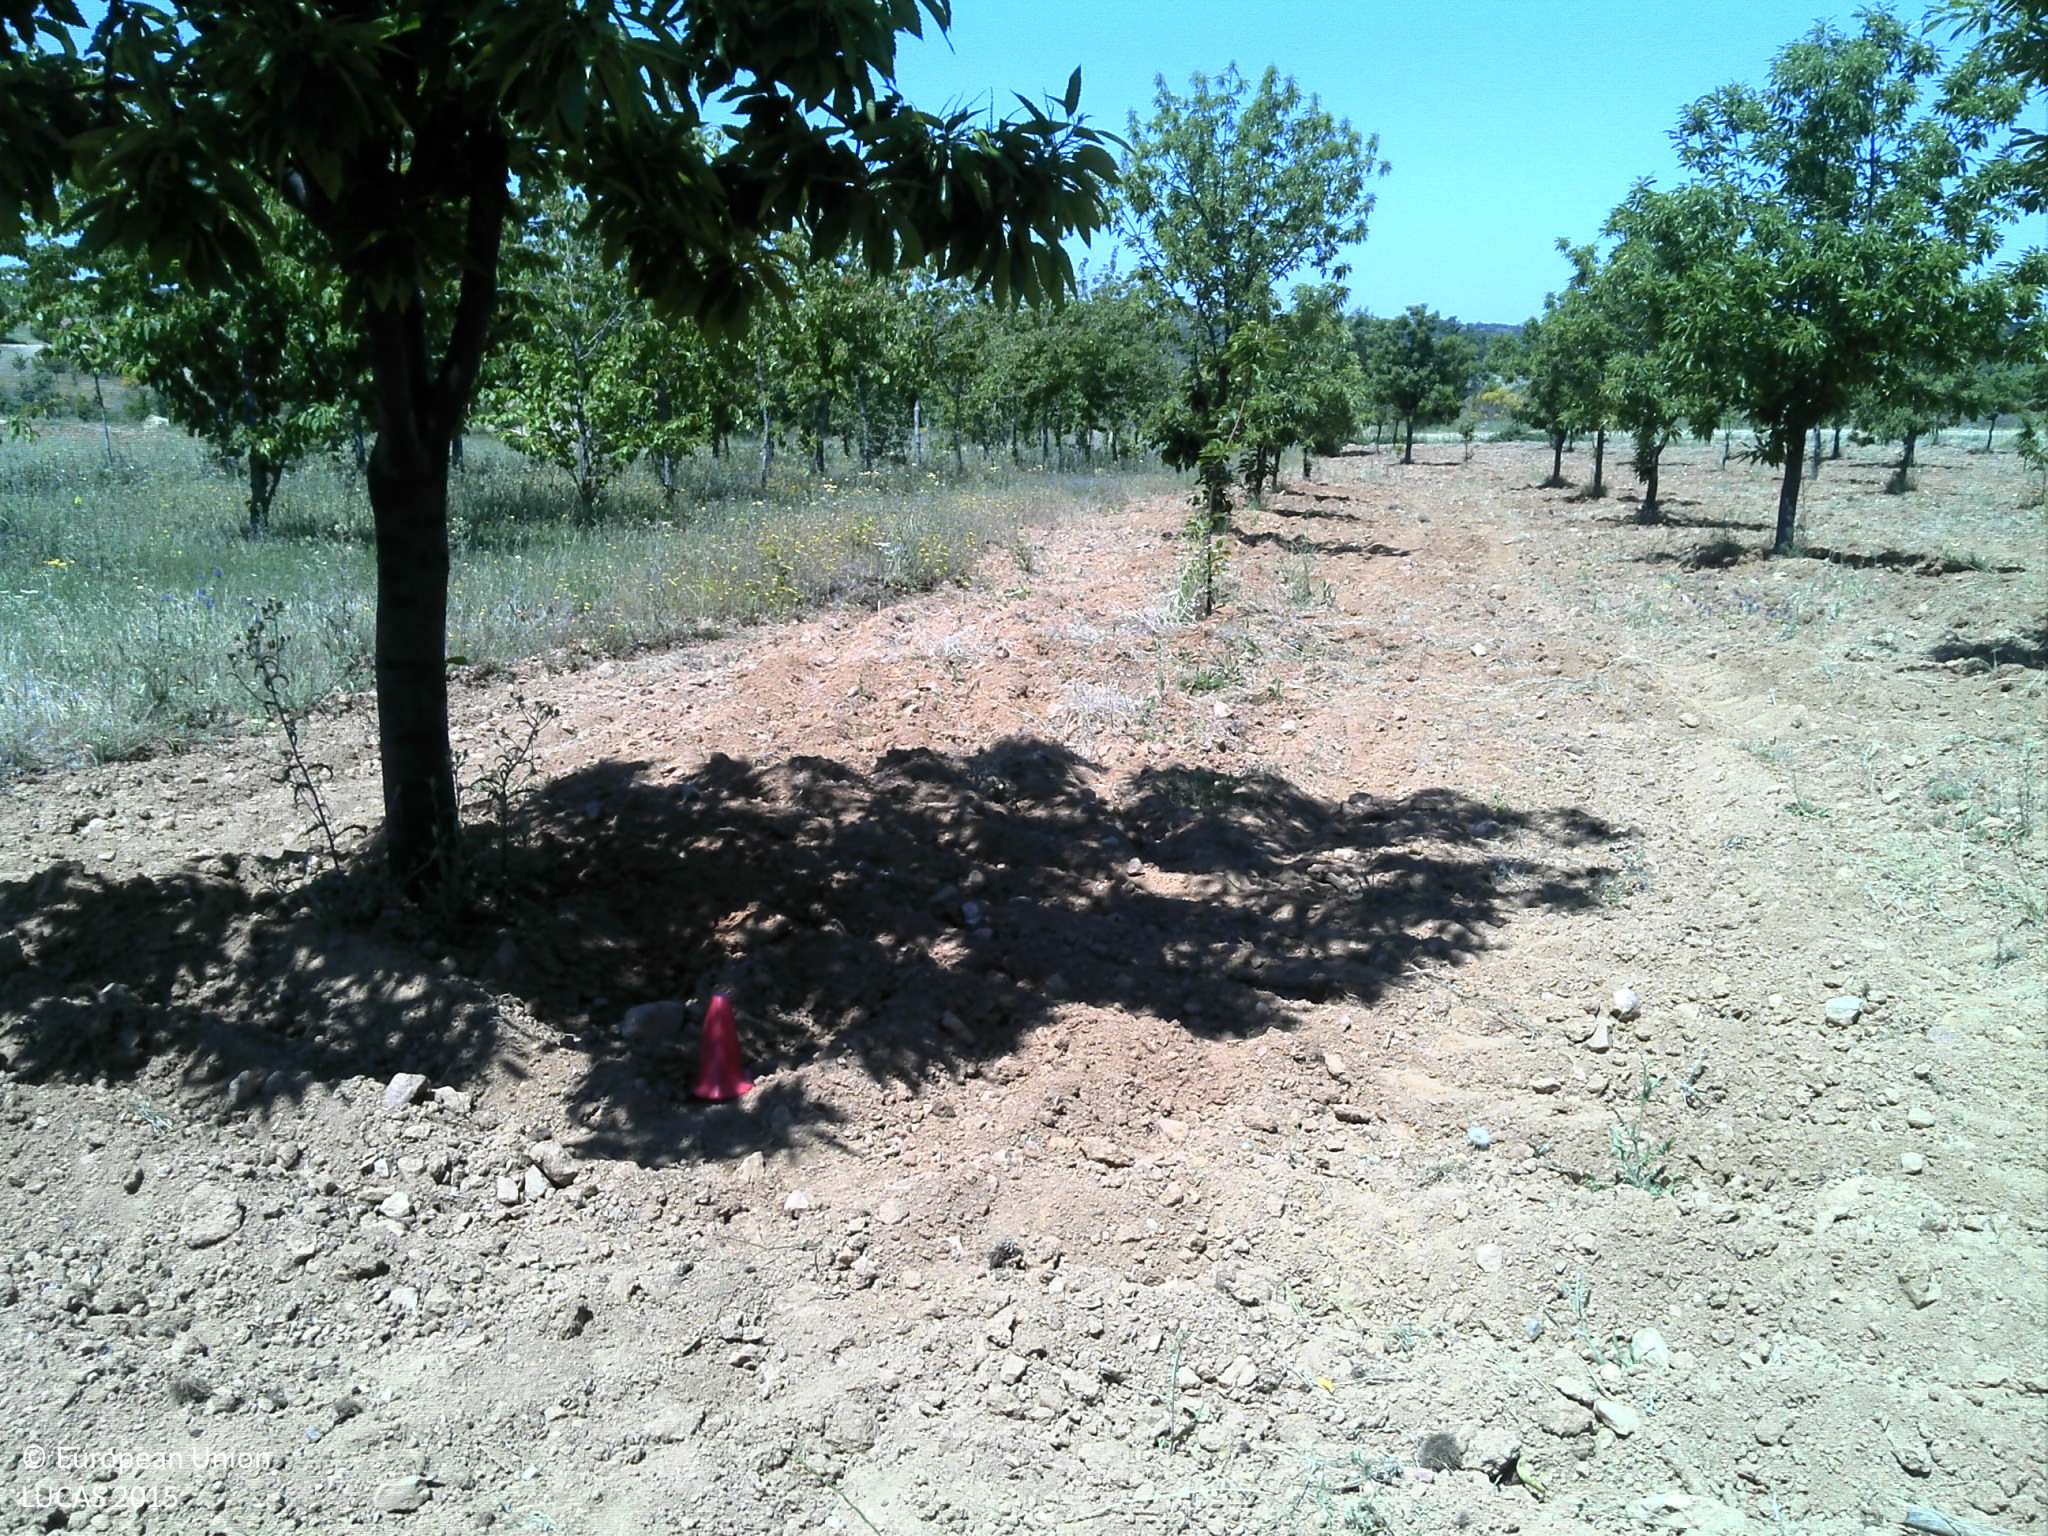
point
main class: Cropland
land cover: Nuts trees
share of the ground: 10 - 25 %
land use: Agriculture (excluding fallow land and kitchen gardens)
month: May
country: PT
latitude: 41.5293
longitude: -6.3880
